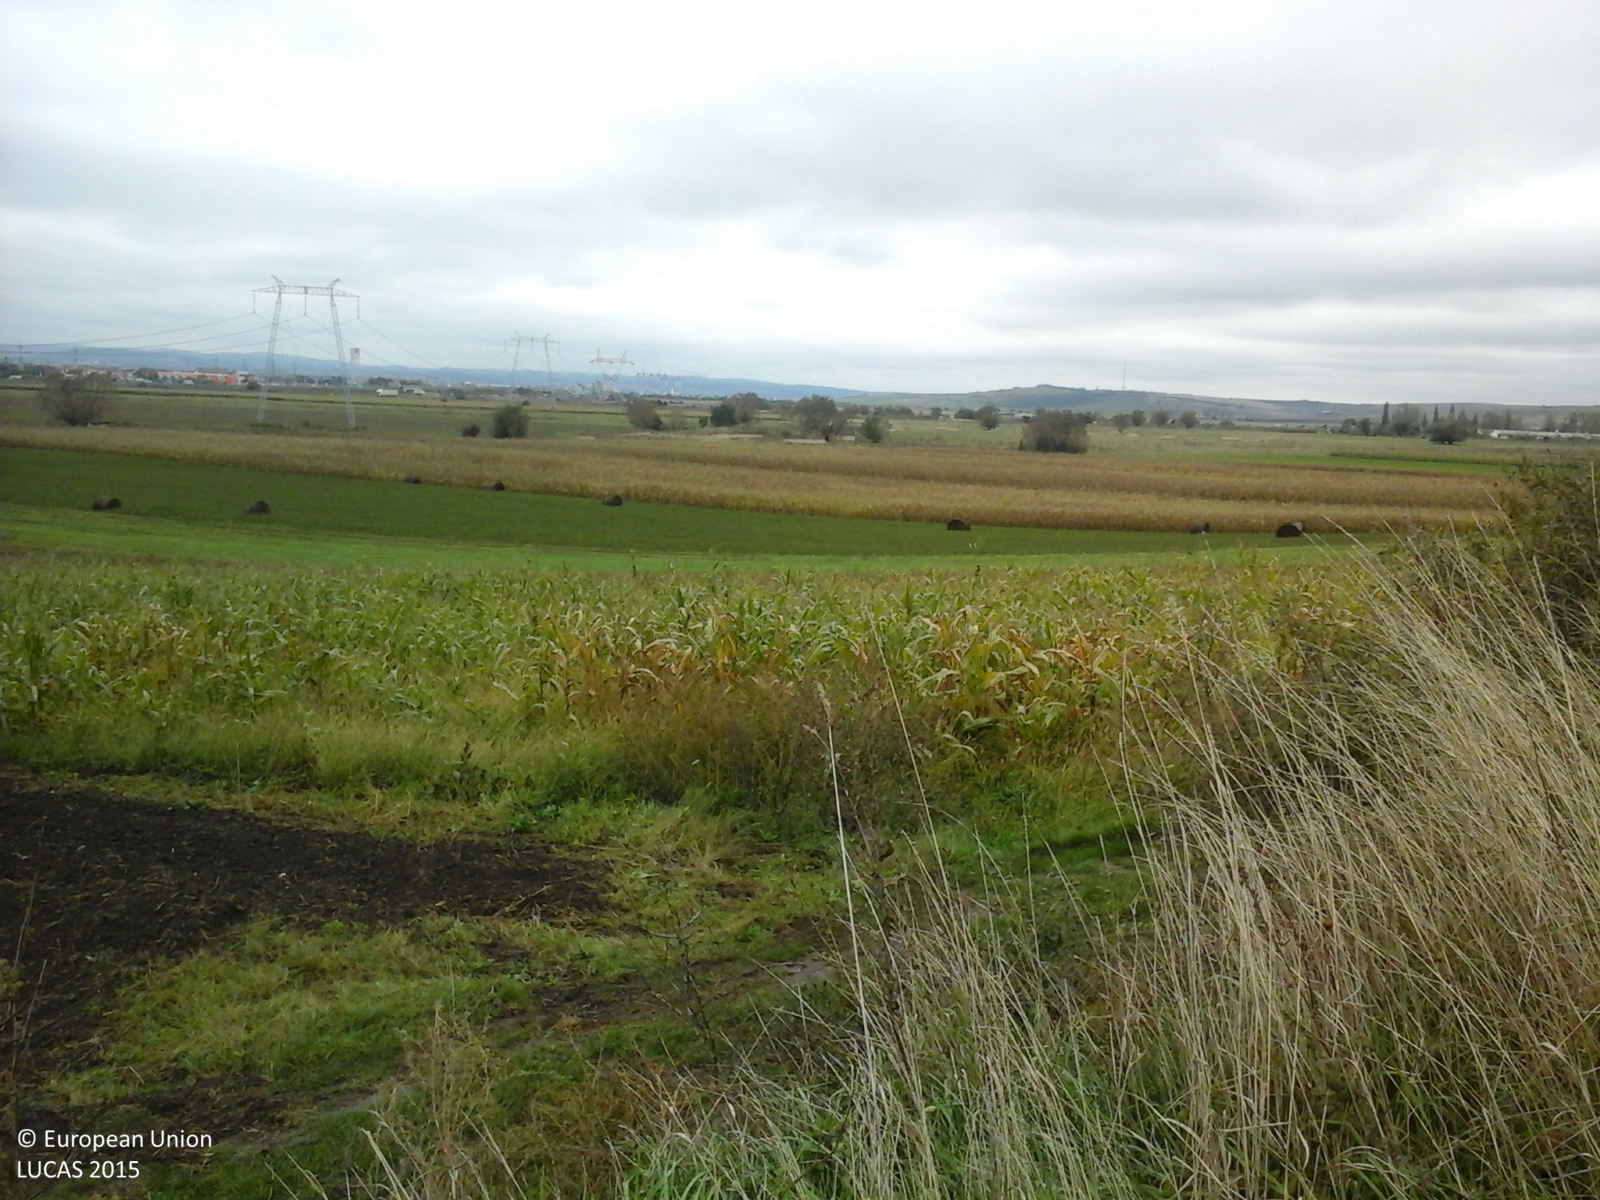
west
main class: Grassland
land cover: Spontaneously vegetated surfaces
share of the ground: > 75 %
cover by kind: herbaceous plants 100 %
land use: Fallow land
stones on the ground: < 10 %
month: October
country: RO
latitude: 45.8225
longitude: 24.1695
